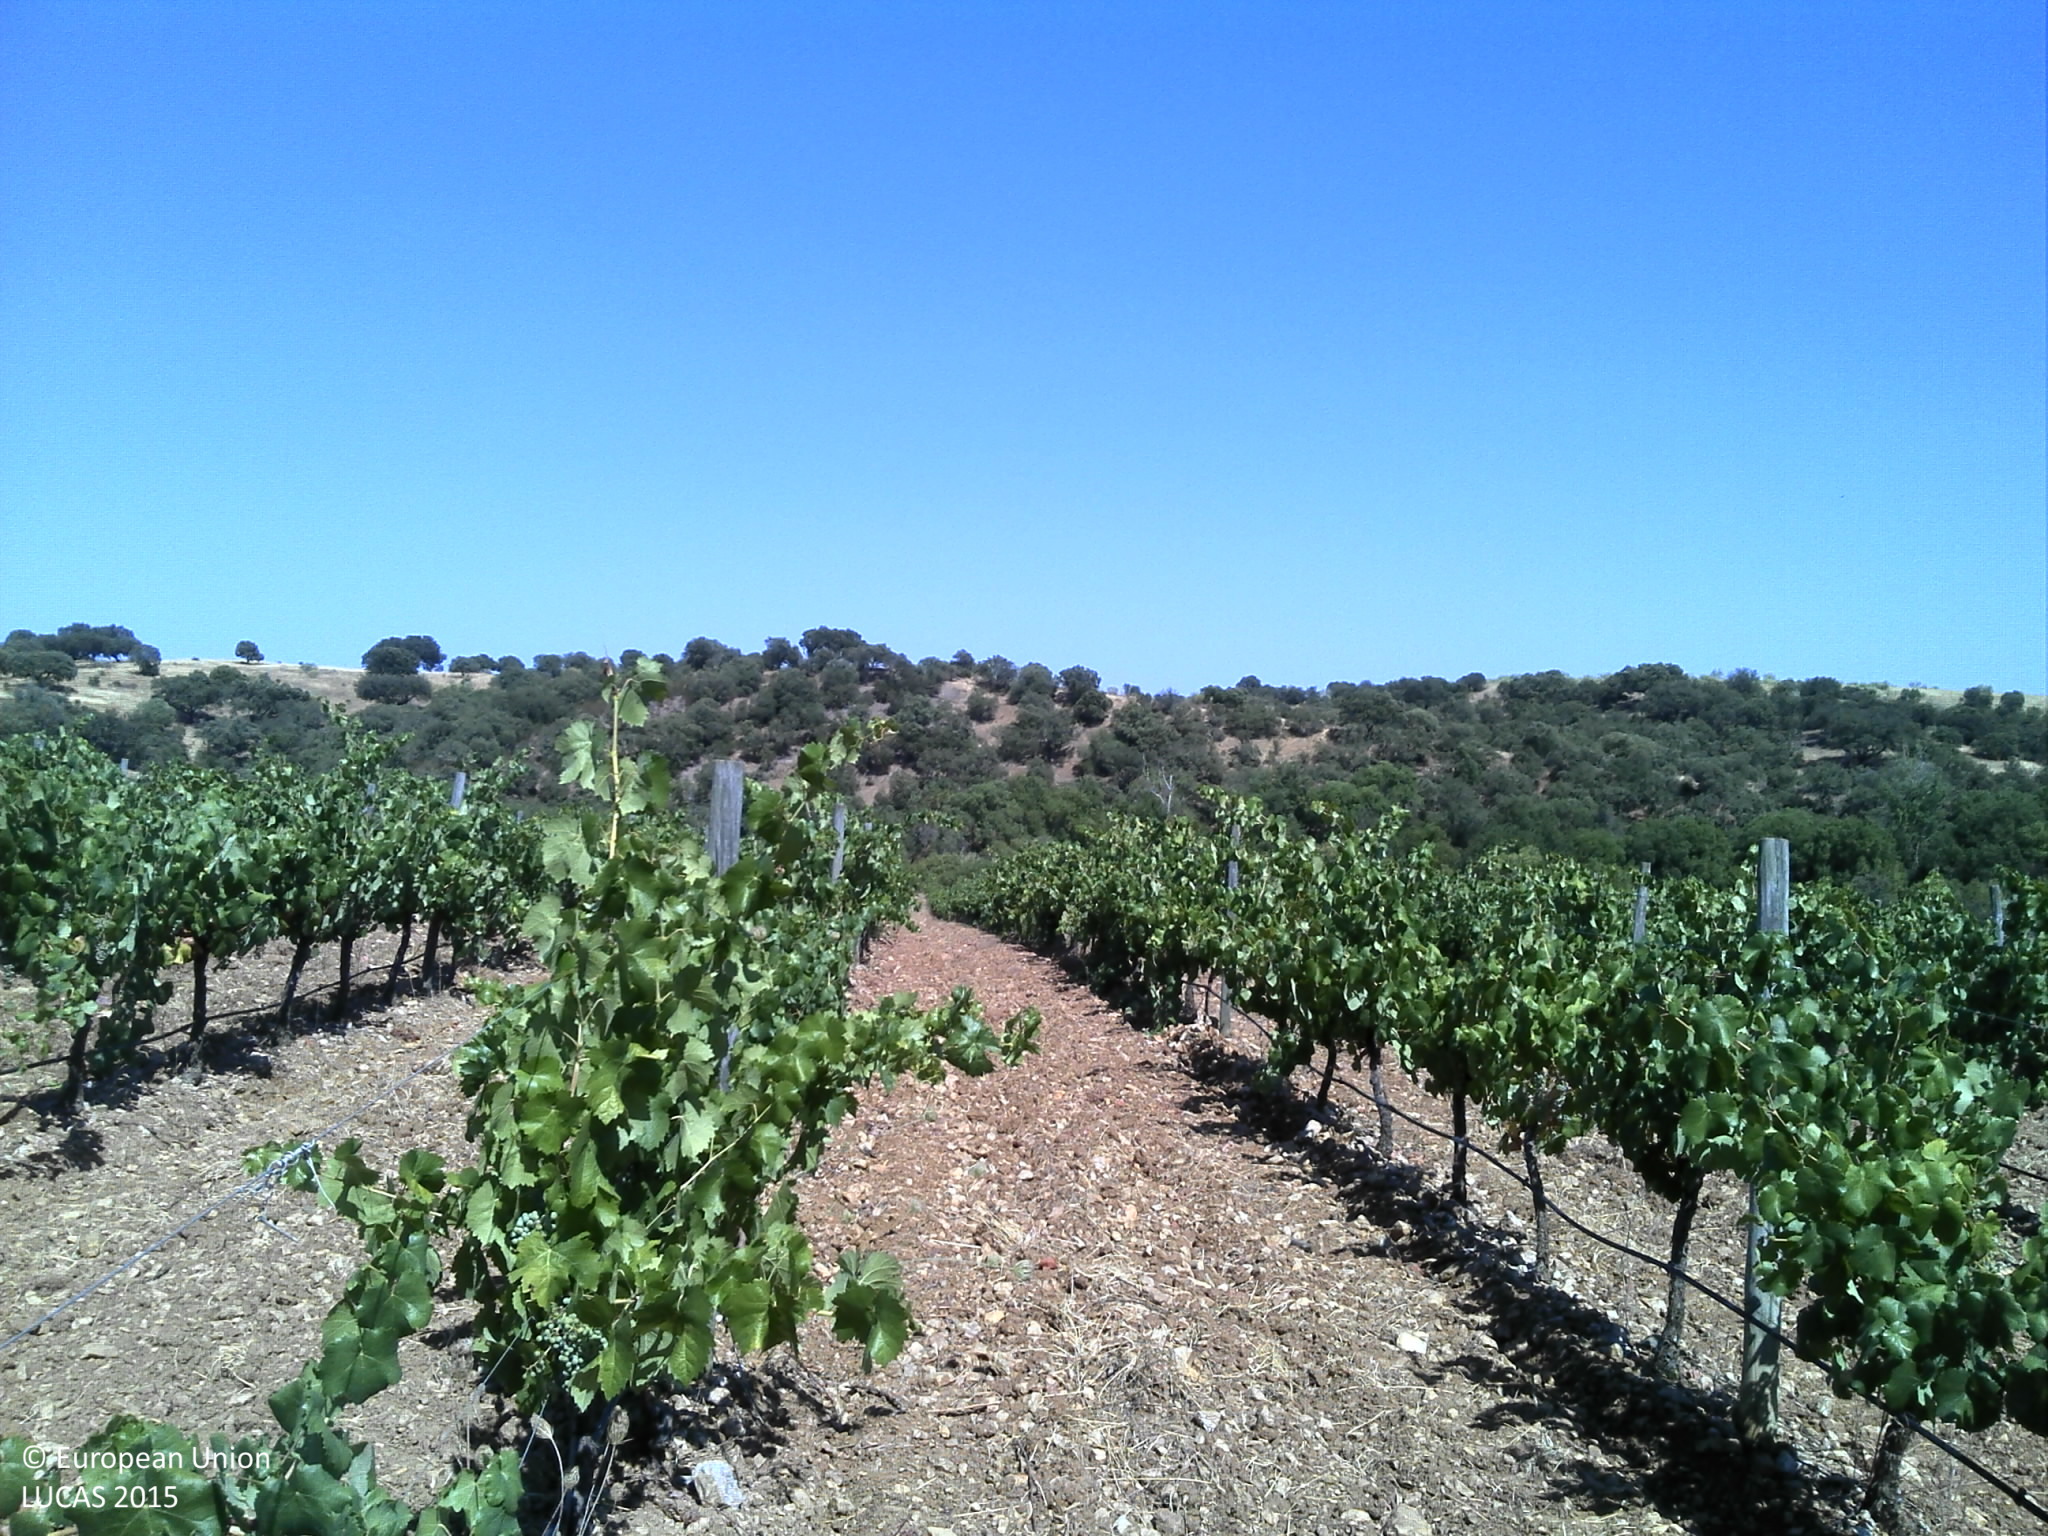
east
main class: Cropland
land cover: Vineyards
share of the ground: 25 - 50 %
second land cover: Other bare soil
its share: > 75 %
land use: Agriculture (excluding fallow land and kitchen gardens)
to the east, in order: Vineyards; Other bare soil; Vineyards; Other bare soil; Fences; Broadleaved woodland; Inland fresh running water; Broadleaved woodland
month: July
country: PT
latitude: 38.4291
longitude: -7.6604
